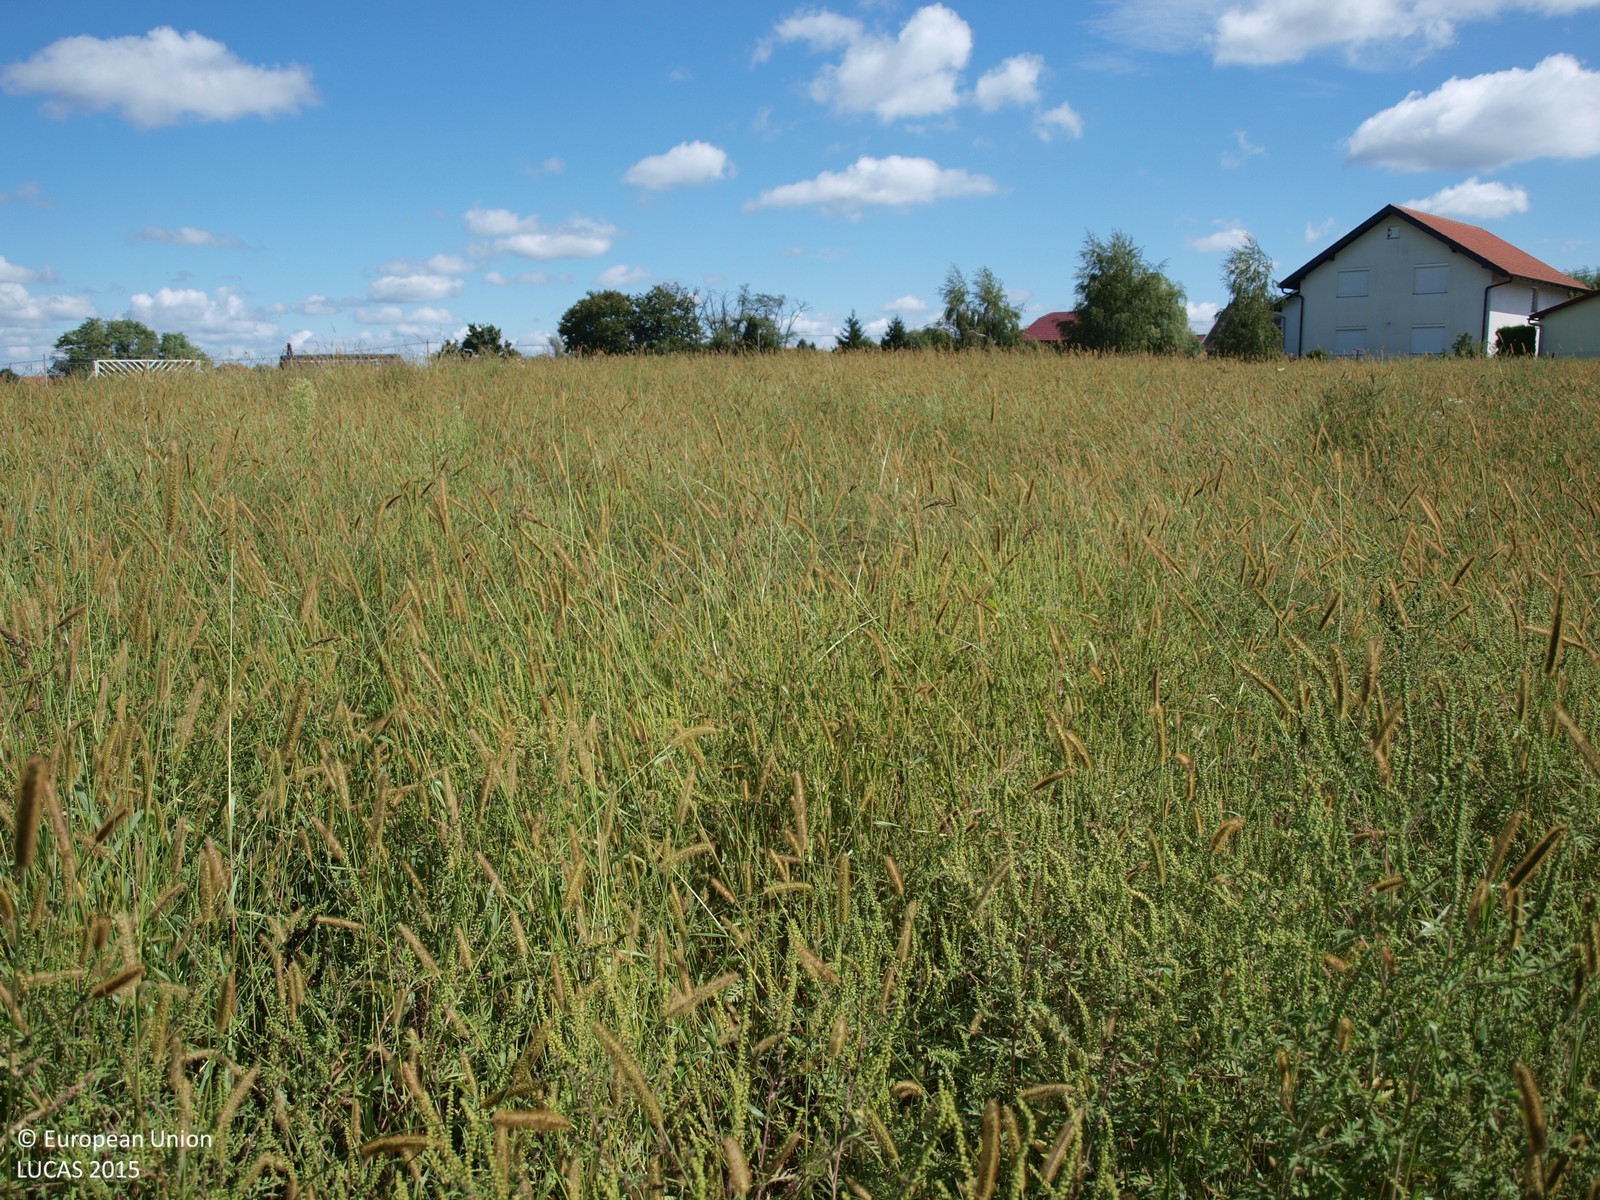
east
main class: Grassland
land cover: Grassland without tree/shrub cover
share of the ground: > 75 %
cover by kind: herbaceous plants 100 %
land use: Agriculture (excluding fallow land and kitchen gardens)
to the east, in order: Grassland without tree/shrub cover; Fences; Grassland without tree/shrub cover; Fences; Grassland without tree/shrub cover; Fences; Apple fruit; Fences; Ditches and canals; Paved roads, cycling and walking lanes; Grass margins; Dry pulses; Grassland without tree/shrub cover; Maize
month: September
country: HR
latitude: 45.7432
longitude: 16.4124
